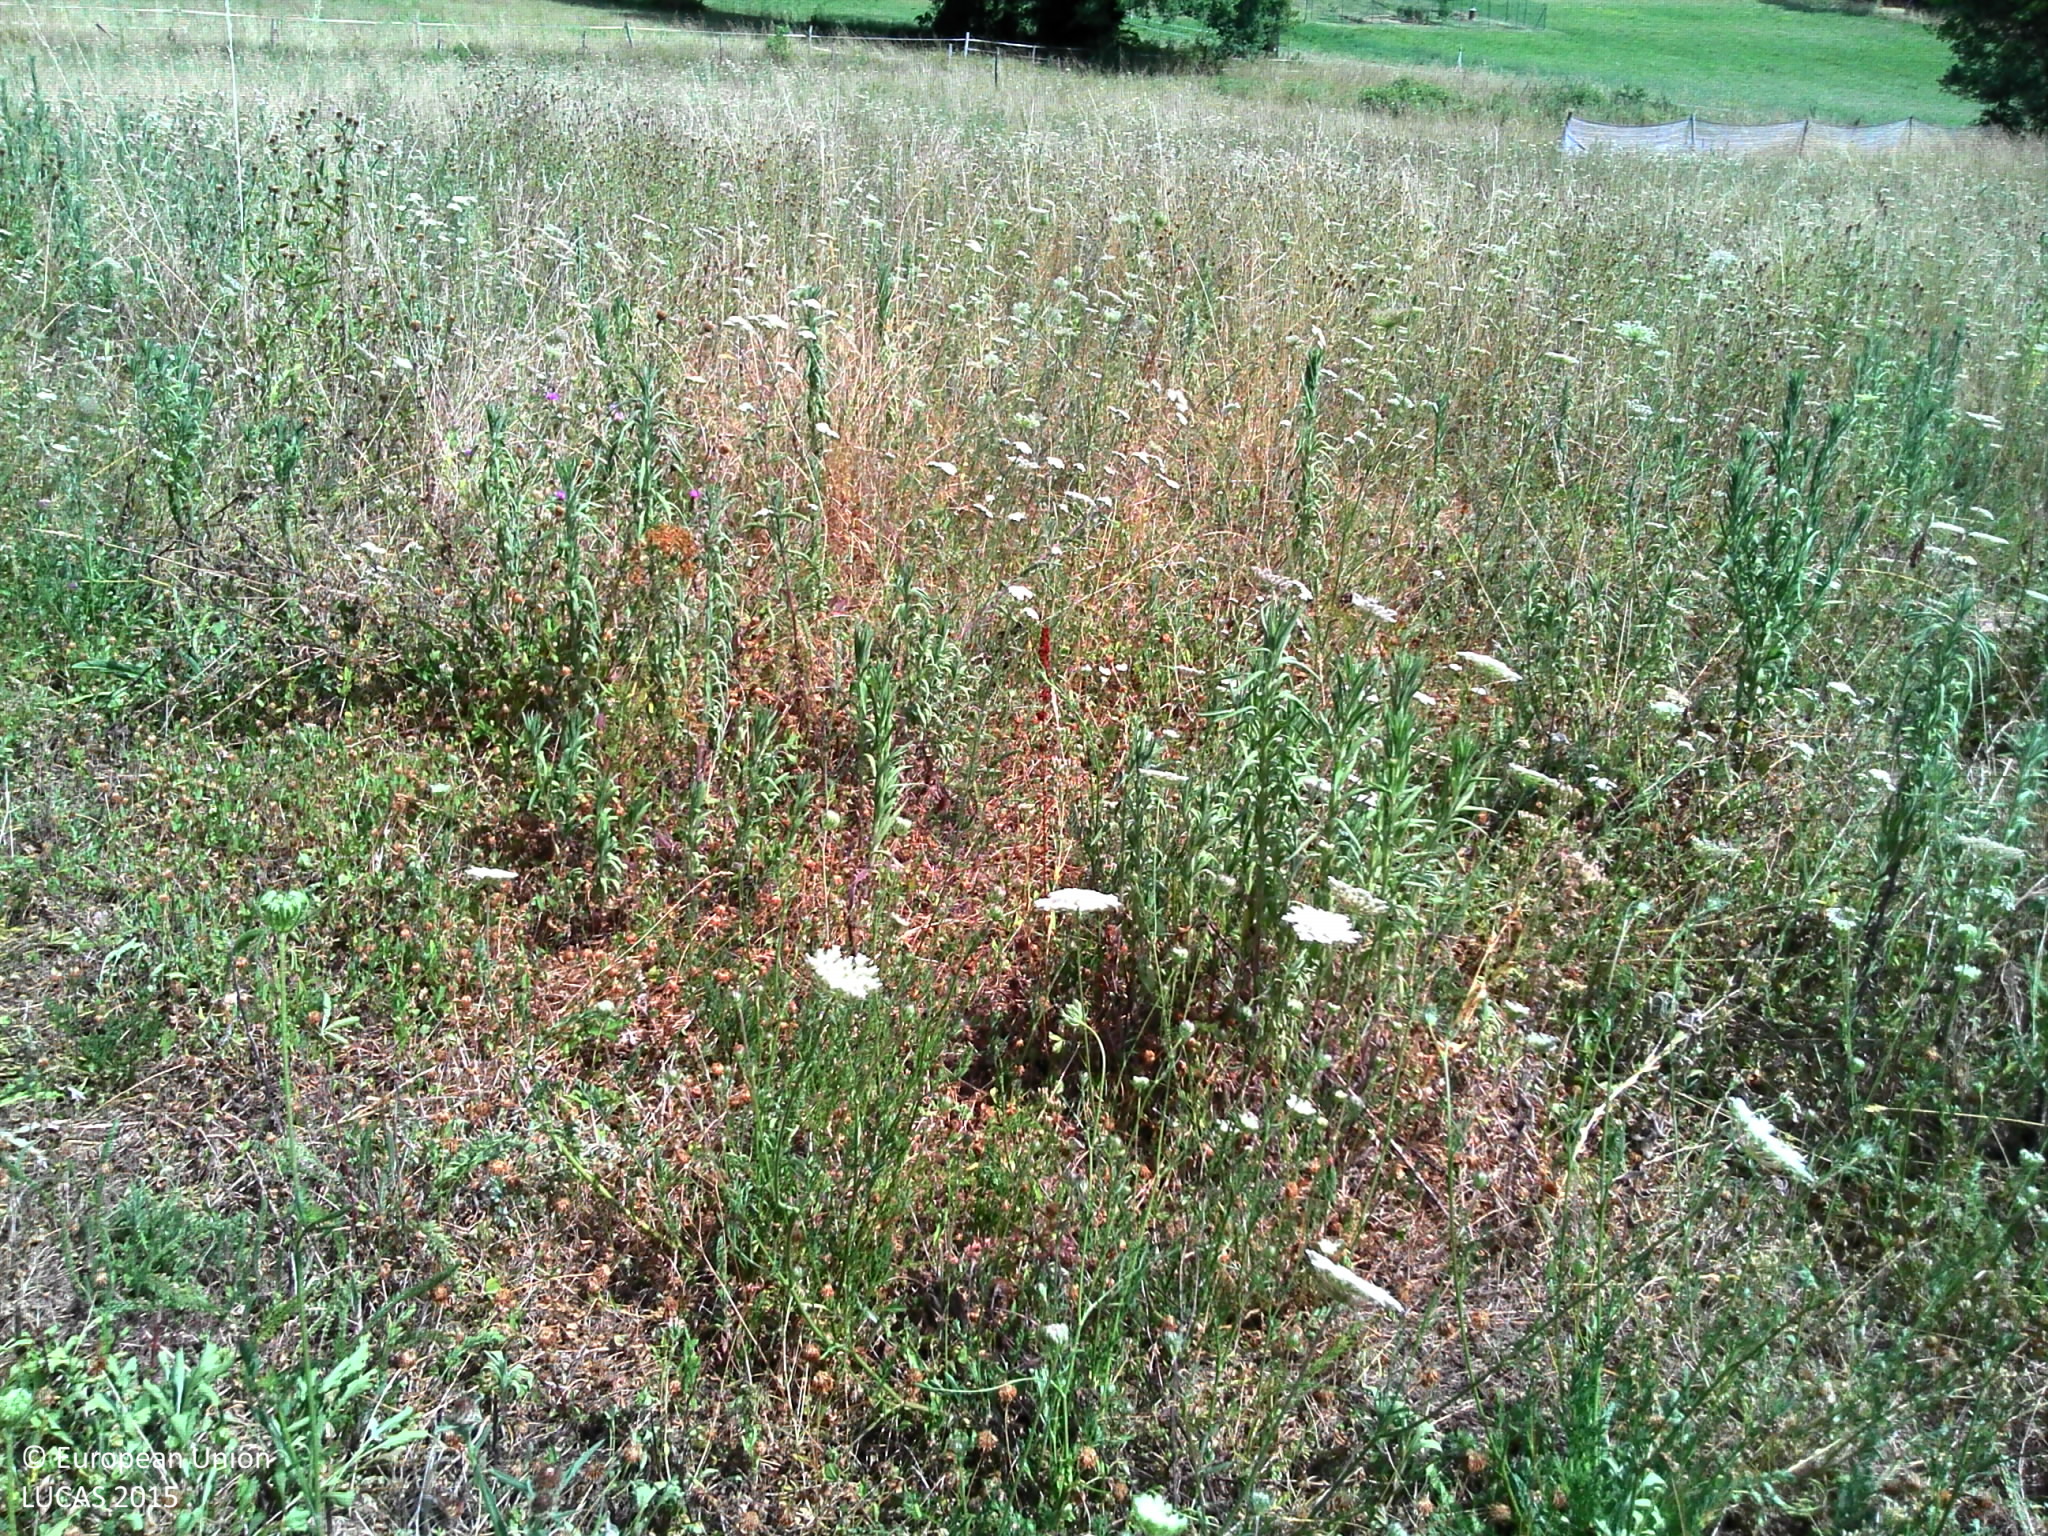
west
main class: Grassland
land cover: Grassland without tree/shrub cover
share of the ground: > 75 %
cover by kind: herbaceous plants 100 %
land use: Agriculture (excluding fallow land and kitchen gardens)
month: July
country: FR
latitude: 45.1527
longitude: 1.1785
